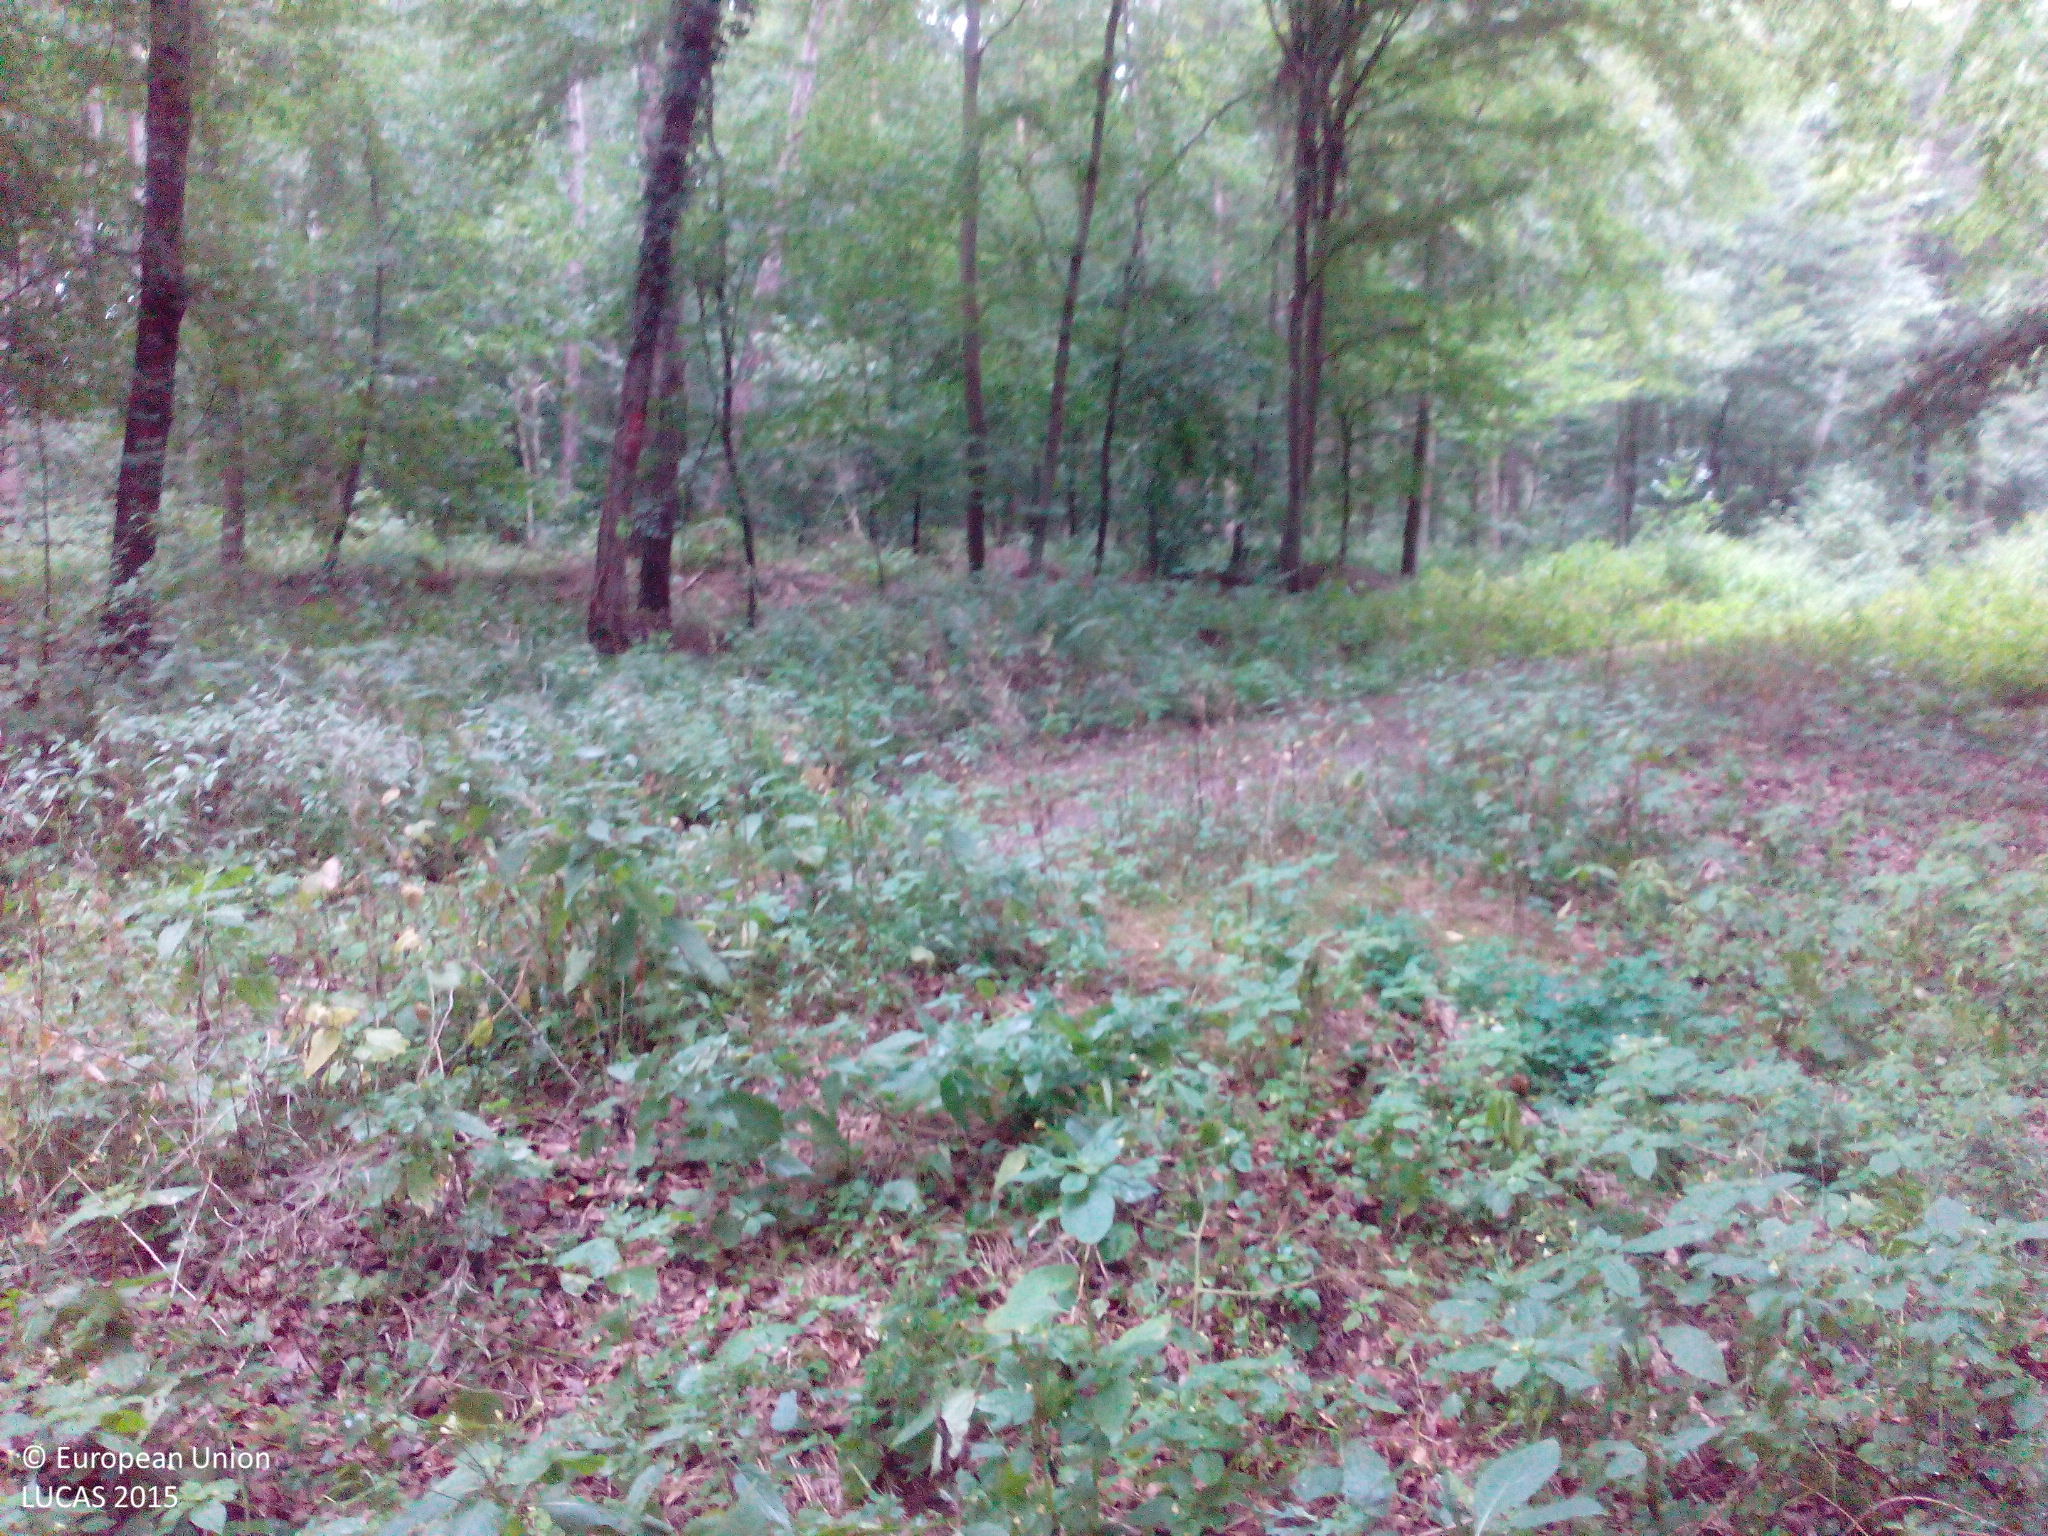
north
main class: Woodland
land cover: Broadleaved woodland
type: beech forest
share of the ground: > 75 %
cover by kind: broadleaved forest trees 85 %, unconsolidated bare surface 10 %, herbaceous plants 5 %
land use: Forestry
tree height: > 5 m
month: August
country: DE
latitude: 50.3469
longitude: 8.0189
